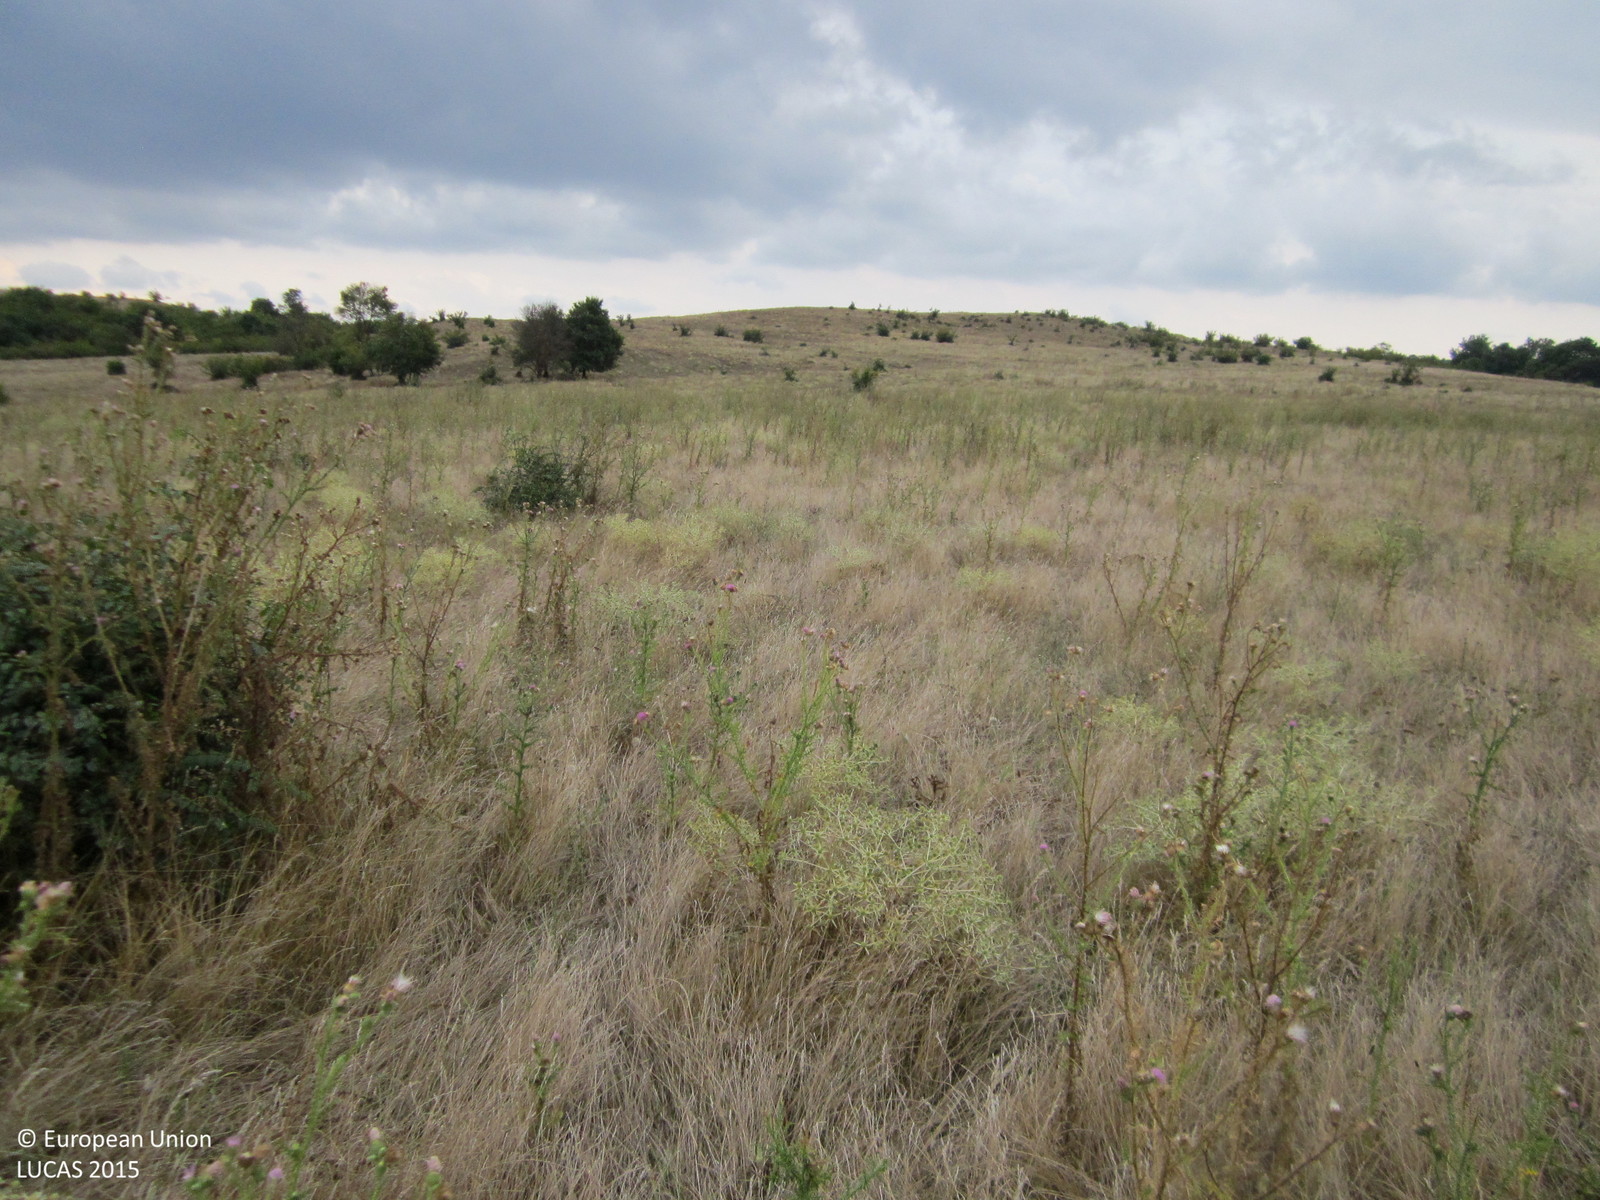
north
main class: Grassland
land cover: Grassland without tree/shrub cover
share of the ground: > 75 %
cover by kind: herbaceous plants 95 %, shrubs 5 %
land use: Agriculture (excluding fallow land and kitchen gardens)
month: August
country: BG
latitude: 42.4967
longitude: 26.9810
